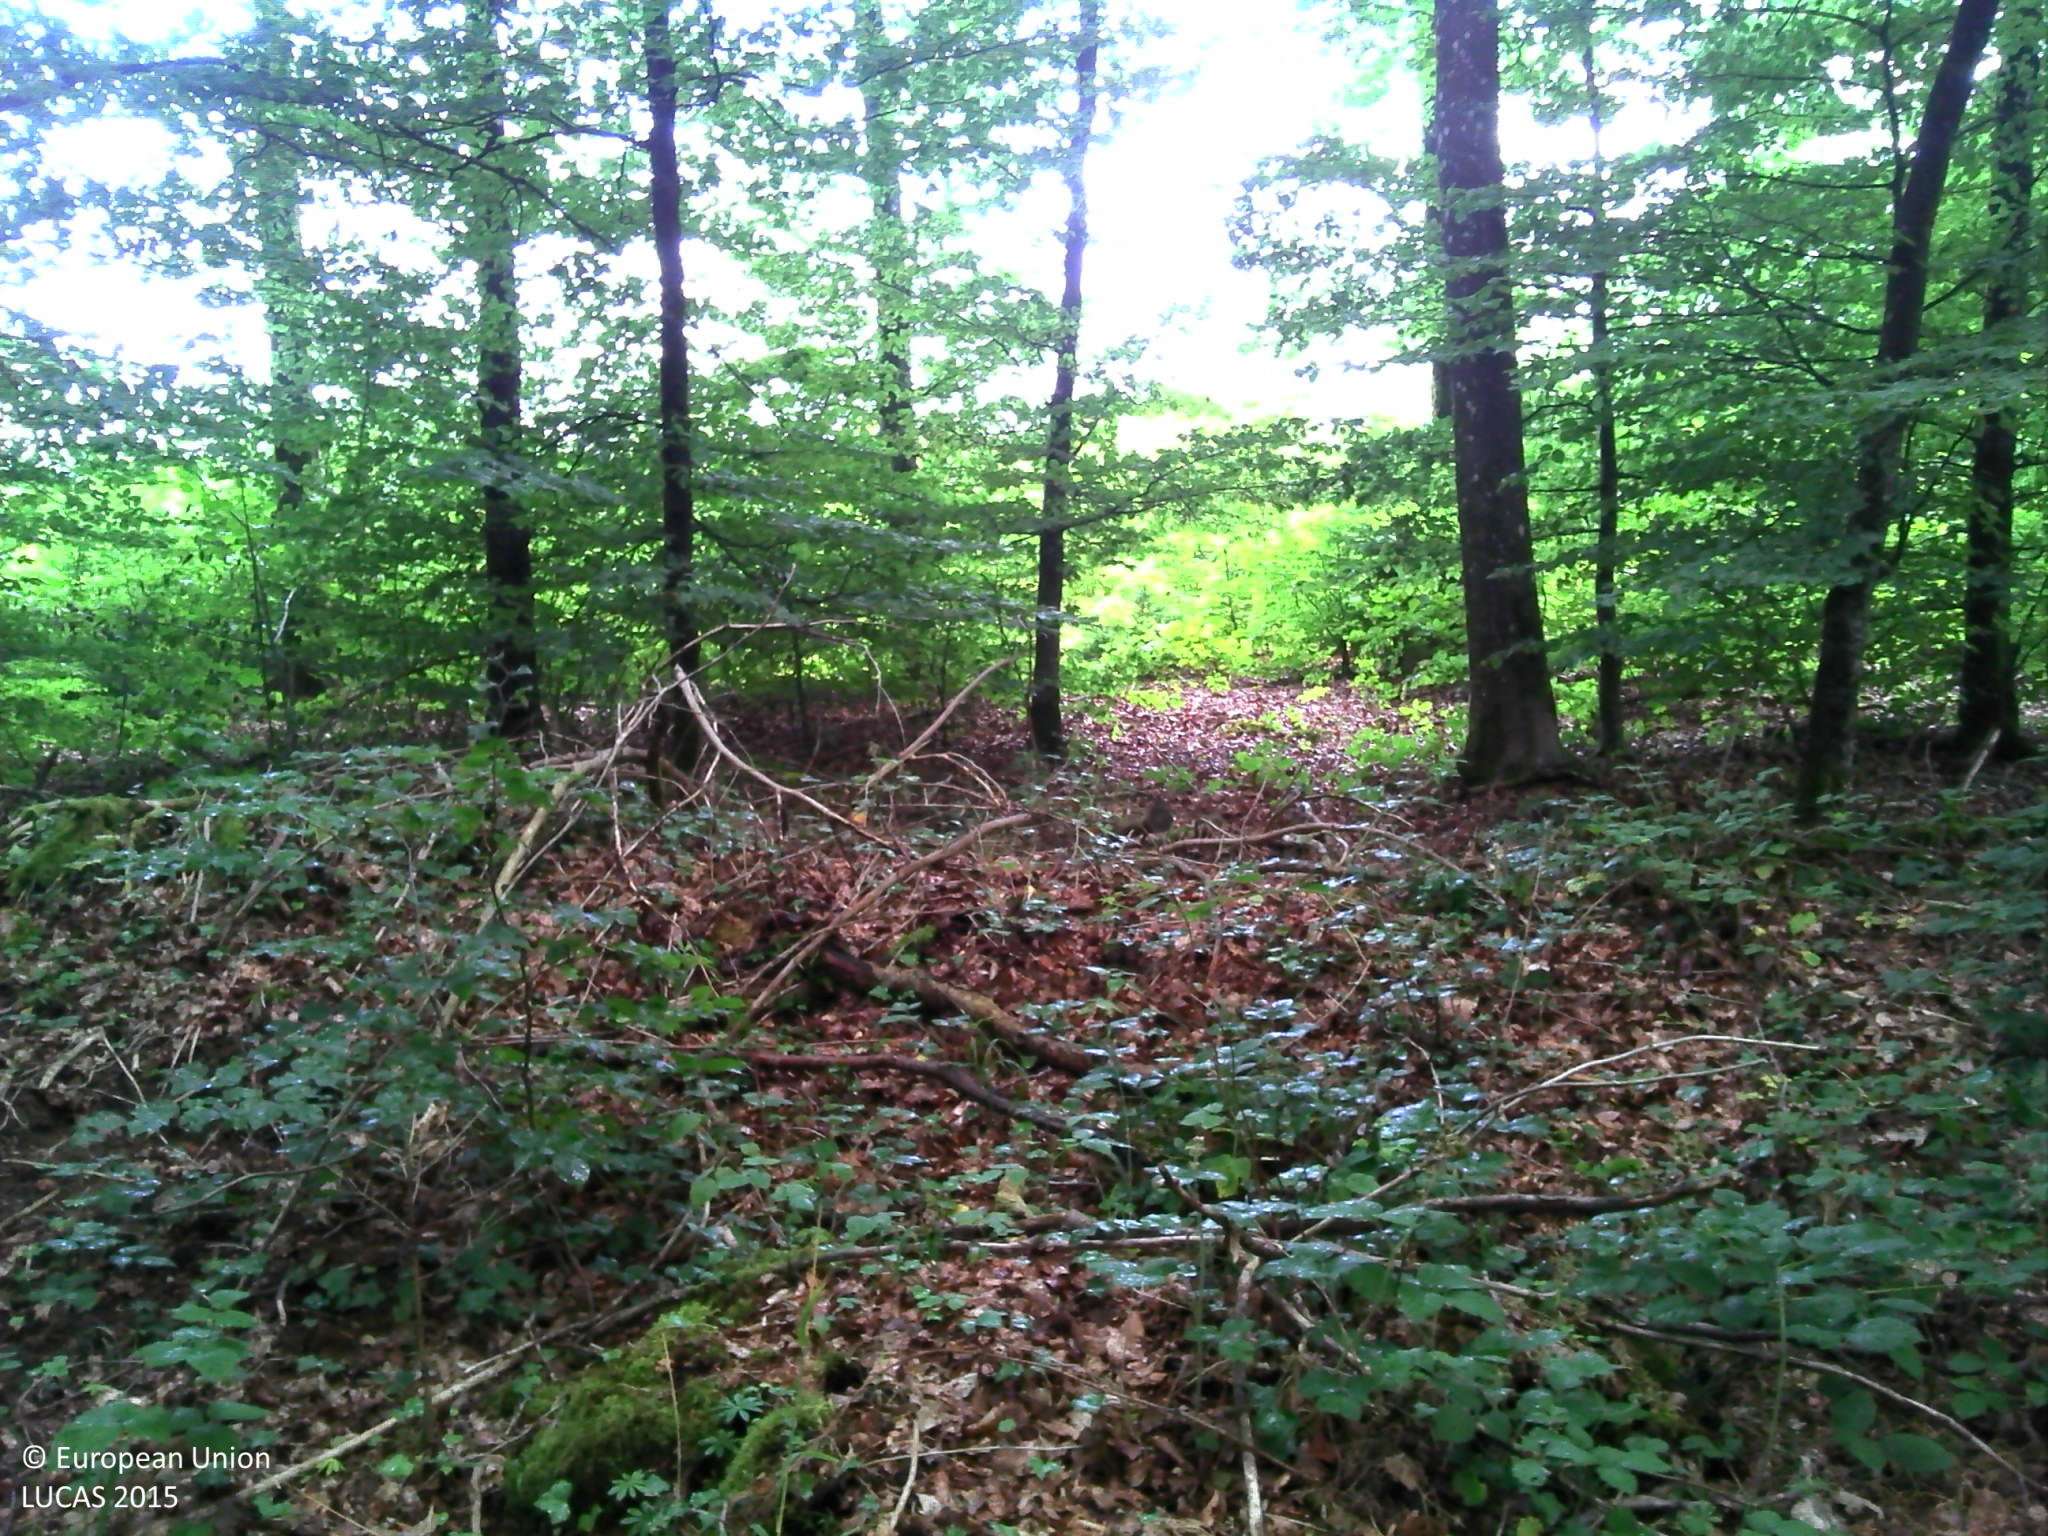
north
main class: Woodland
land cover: Broadleaved woodland
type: beech forest
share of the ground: > 75 %
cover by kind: broadleaved forest trees 95 %, coniferous forest trees 5 %
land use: Forestry
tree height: > 5 m
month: July
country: BE
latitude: 49.6368
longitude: 5.7479
